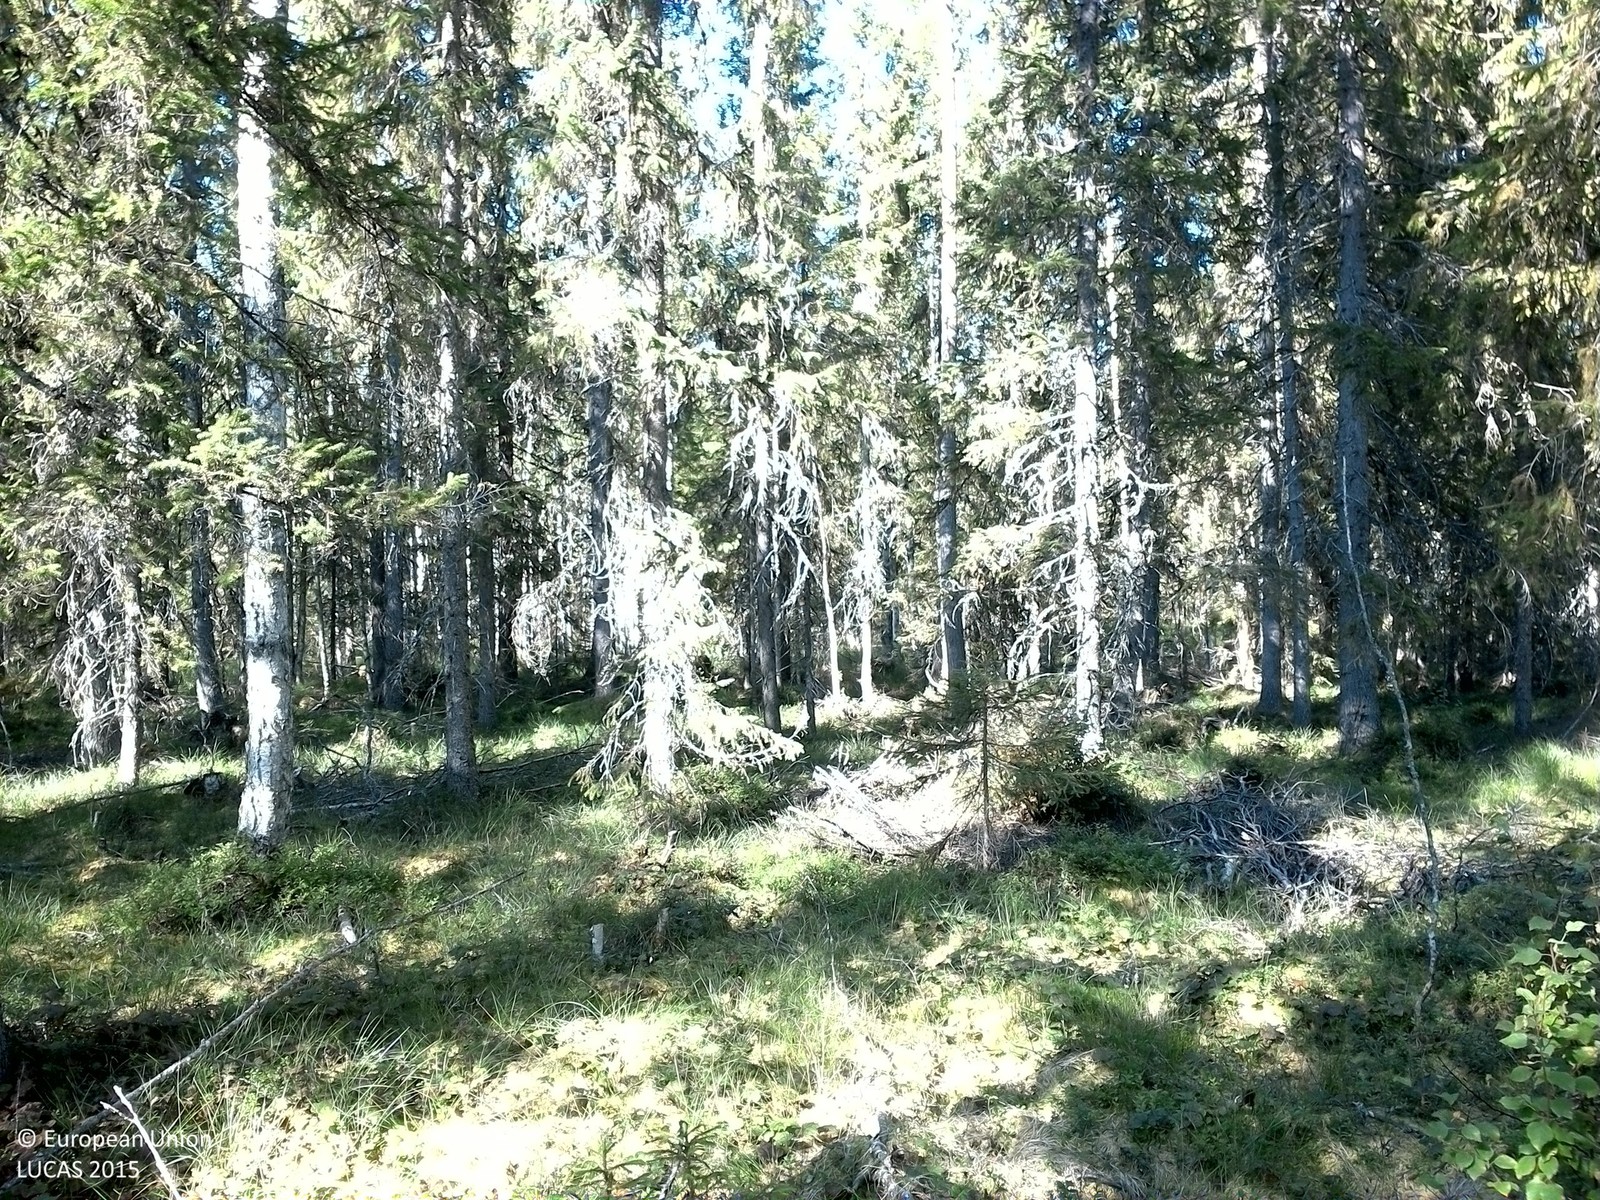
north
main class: Woodland
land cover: Pine dominated mixed woodland
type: boreal forest
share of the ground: 50 - 75 %
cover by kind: coniferous forest trees 40 %, broadleaved forest trees 25 %, lichens and mosses 20 %, herbaceous plants 10 %, shrubs 5 %
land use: Forestry
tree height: > 5 m
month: August
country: SE
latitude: 63.6816
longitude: 17.3921
